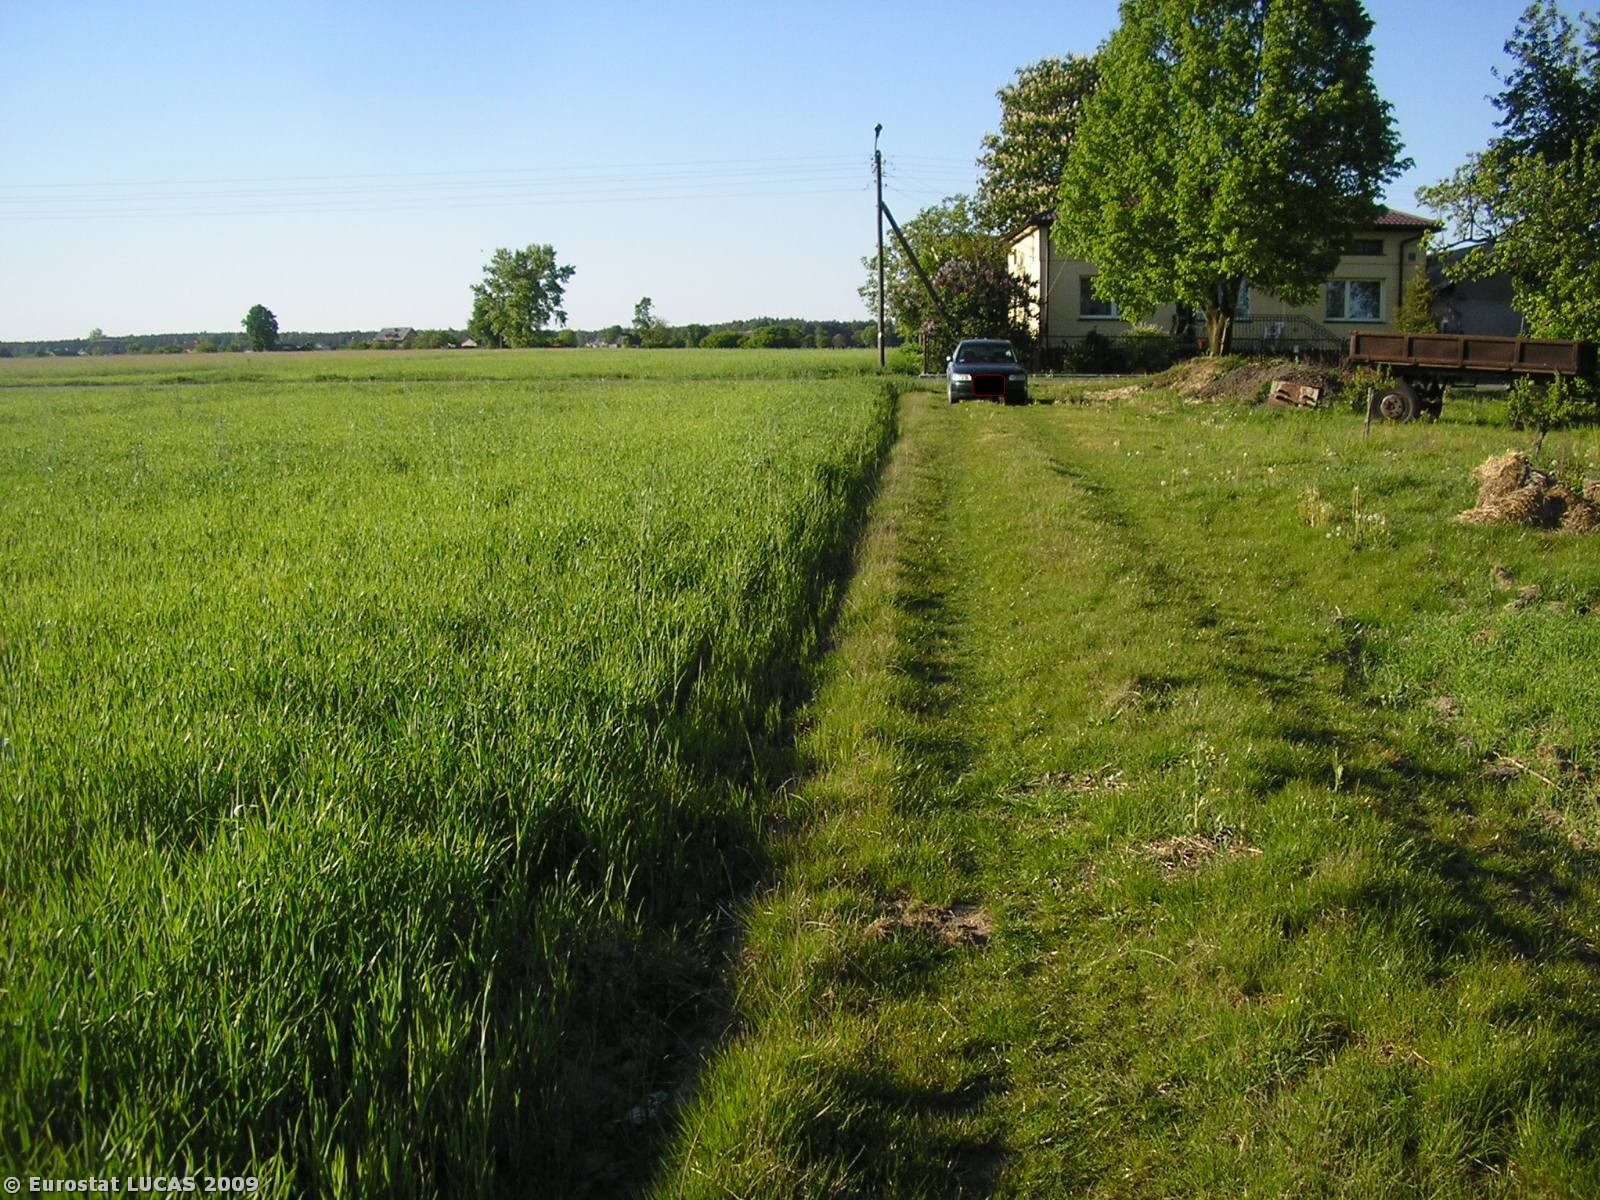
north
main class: Cropland
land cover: Triticale
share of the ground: > 75 %
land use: Agriculture (excluding fallow land and kitchen gardens)
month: May
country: PL
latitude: 51.6648
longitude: 19.9942
